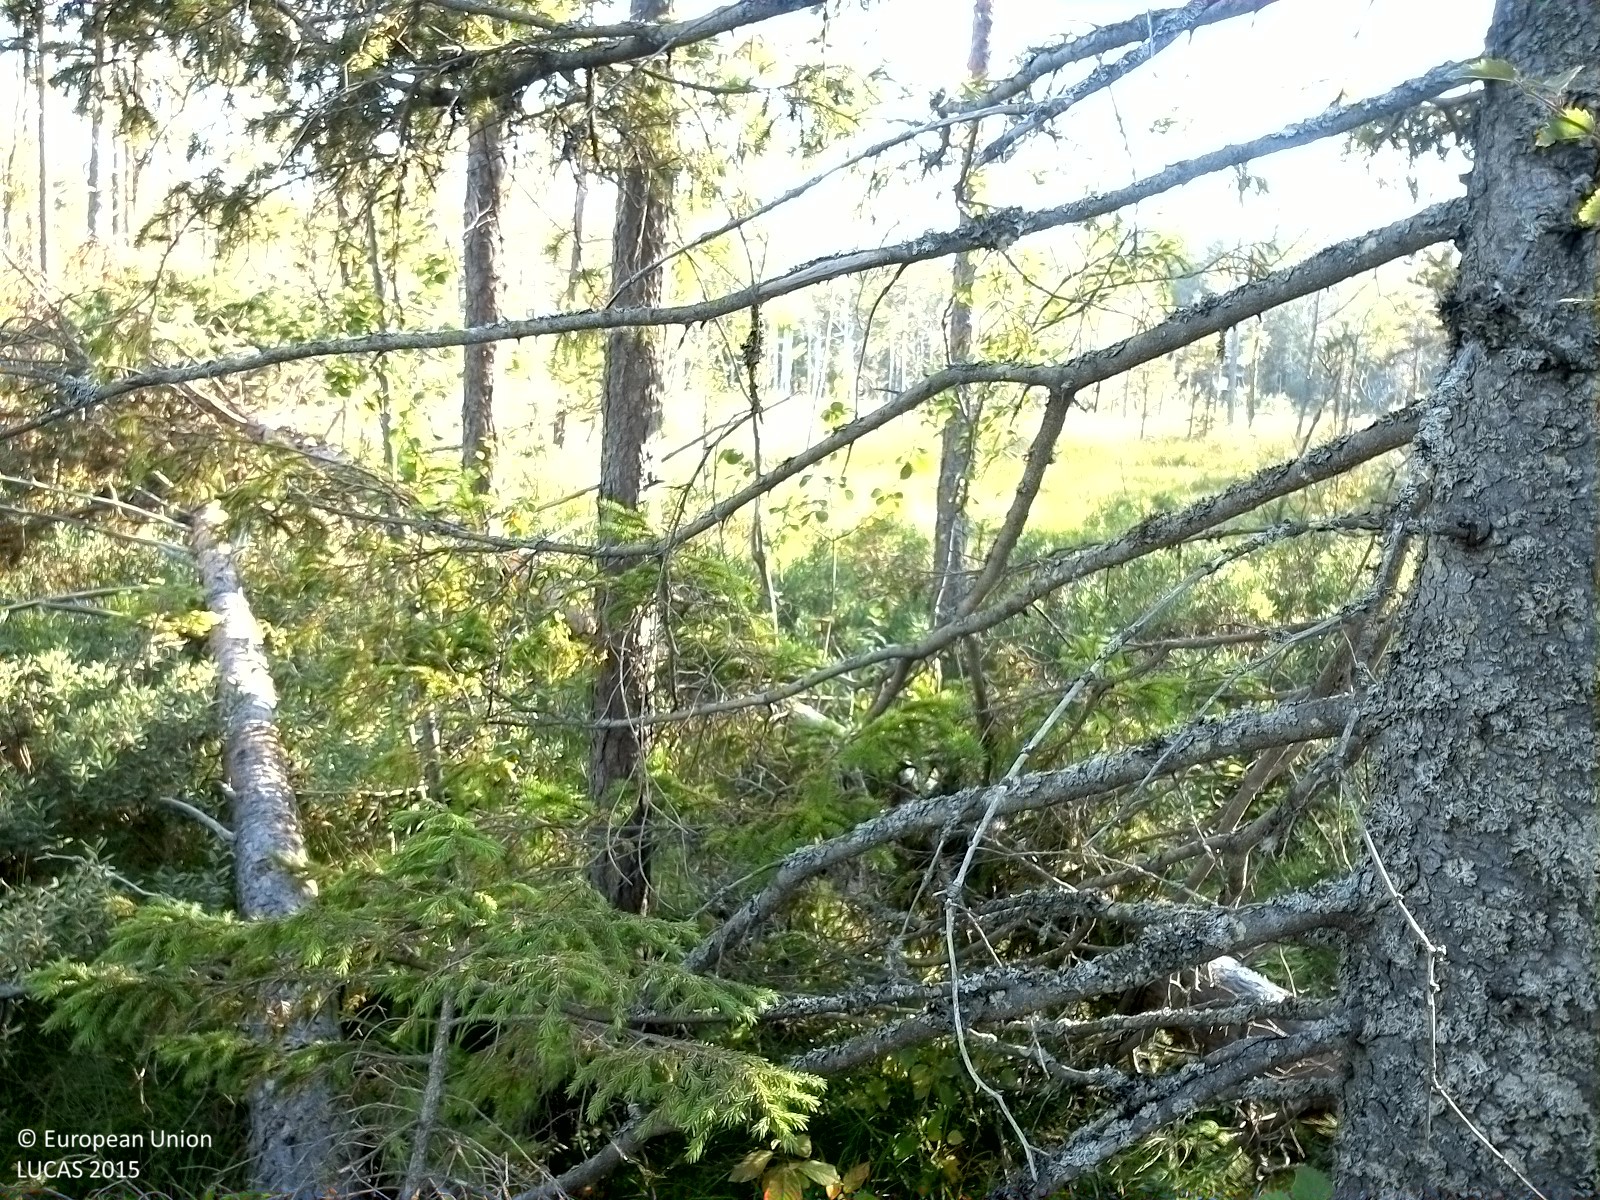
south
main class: Woodland
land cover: Other mixed woodland
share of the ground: 50 - 75 %
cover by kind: coniferous forest trees 30 %, broadleaved forest trees 20 %, herbaceous plants 20 %, lichens and mosses 20 %, shrubs 10 %
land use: Forestry
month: August
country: SE
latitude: 62.6058
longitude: 17.8704
